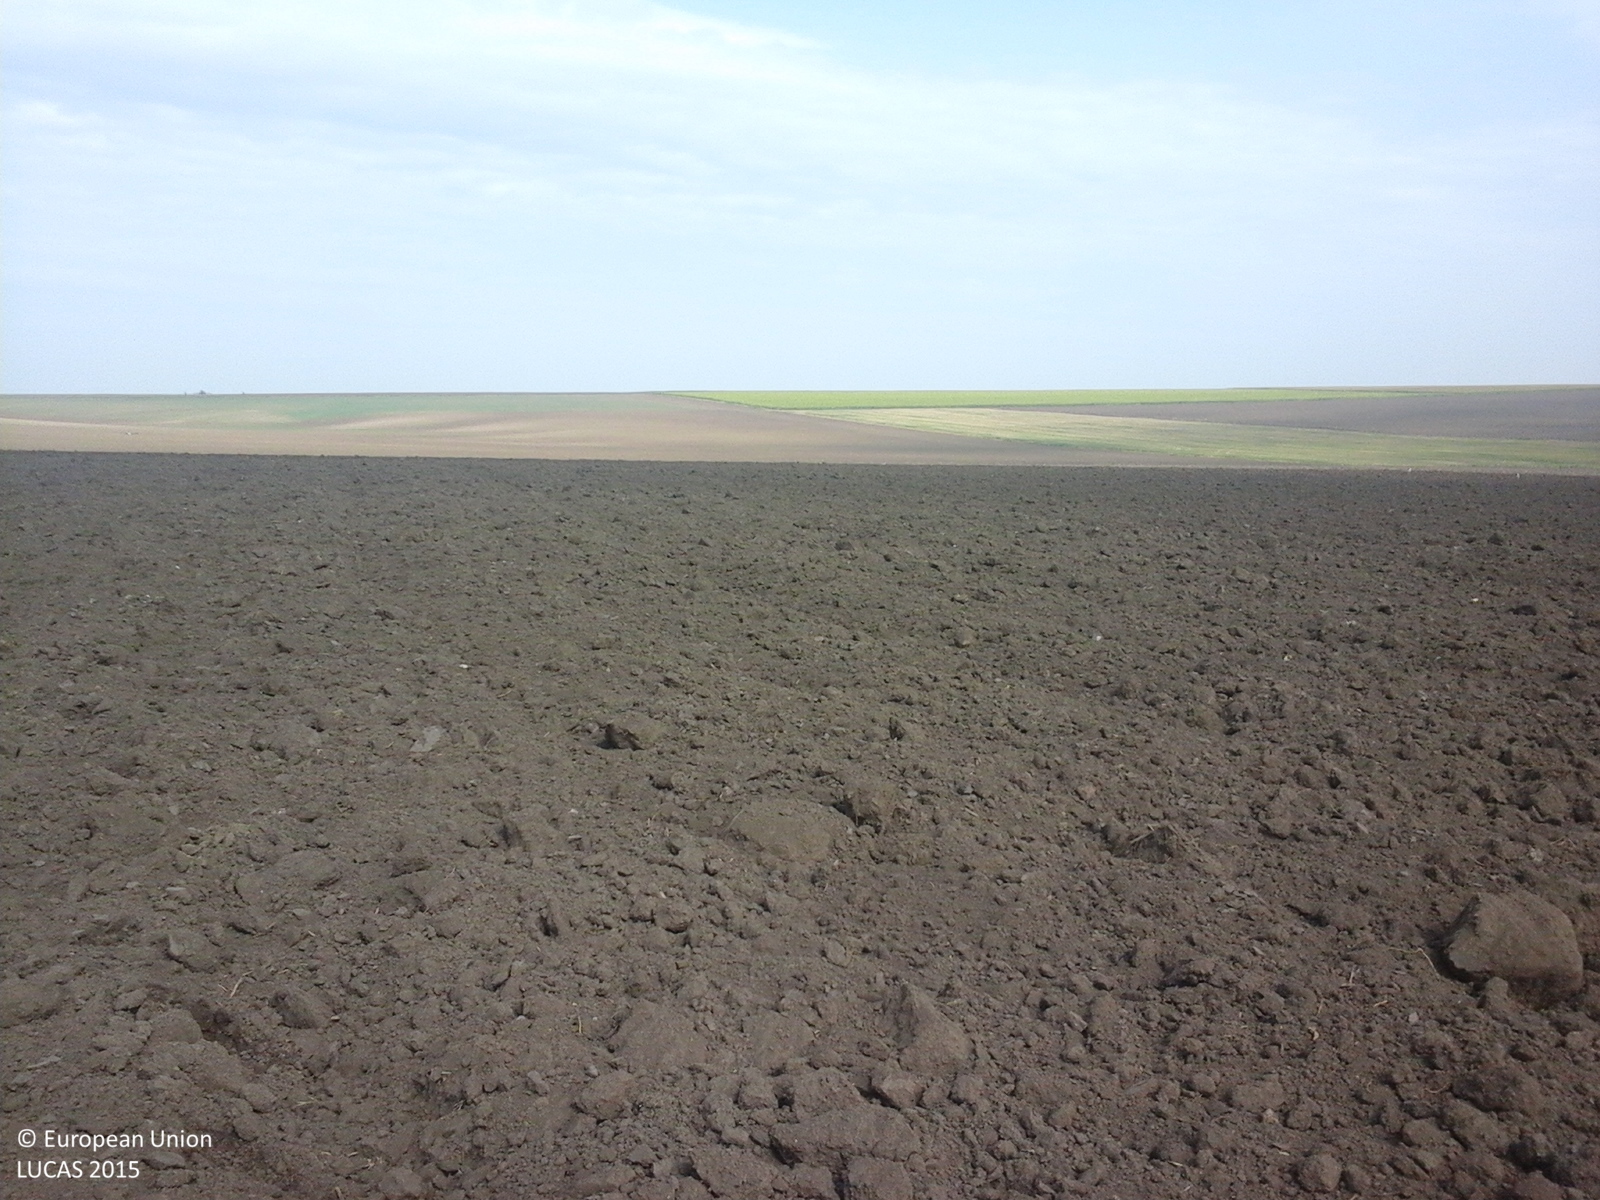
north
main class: Cropland
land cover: Common wheat
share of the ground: < 10 %
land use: Agriculture (excluding fallow land and kitchen gardens)
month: August
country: RO
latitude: 43.8140
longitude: 28.0919
